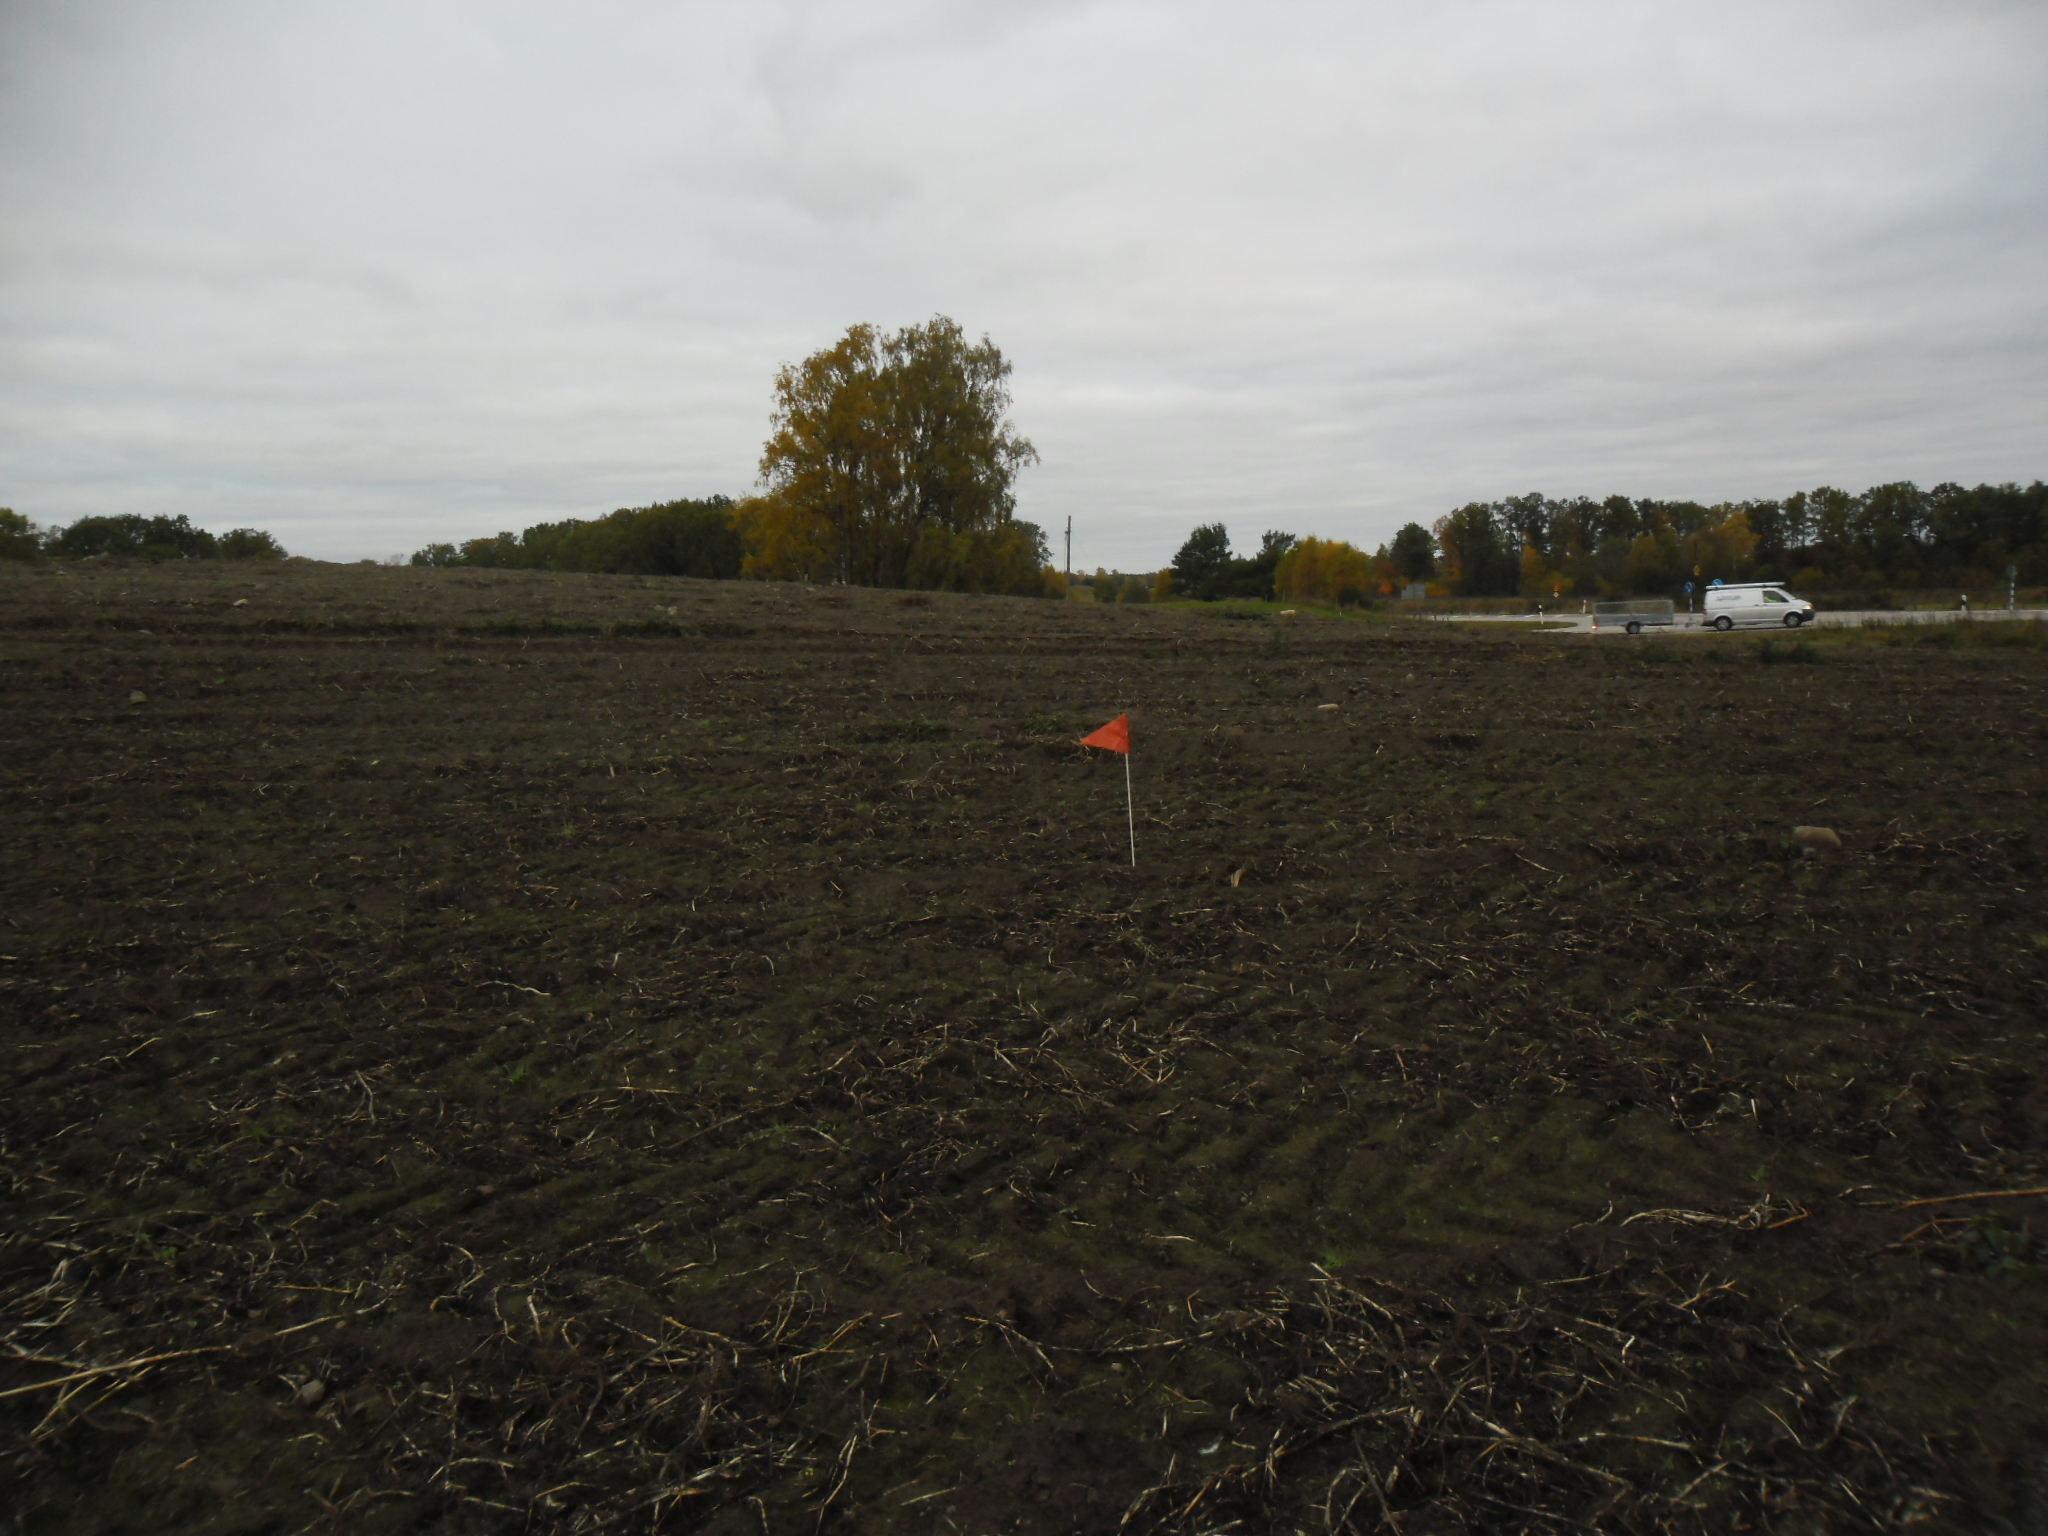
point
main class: Cropland
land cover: Potatoes
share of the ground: < 10 %
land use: Agriculture (excluding fallow land and kitchen gardens)
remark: Harvested field
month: October
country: SE
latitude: 56.1870
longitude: 13.7517
